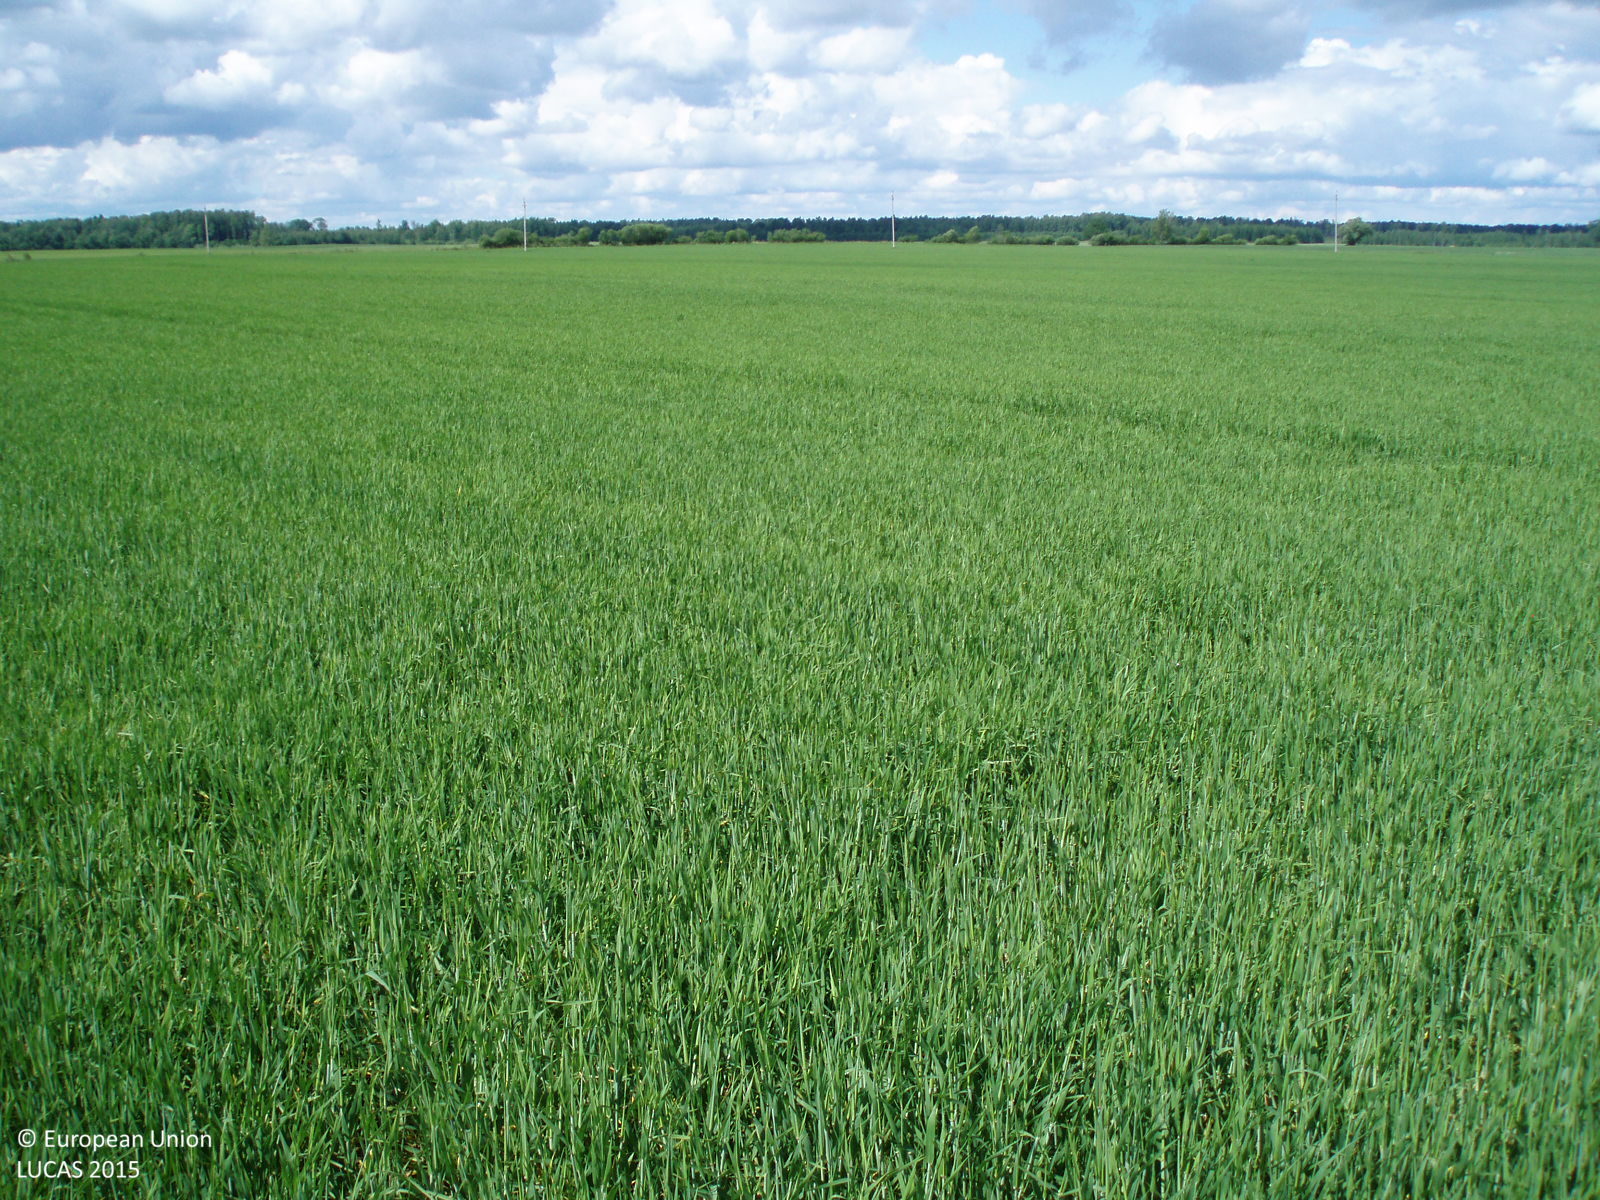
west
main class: Cropland
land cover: Barley
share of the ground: > 75 %
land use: Agriculture (excluding fallow land and kitchen gardens)
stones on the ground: < 10 %
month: June
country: LT
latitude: 56.2619
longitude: 23.2614
